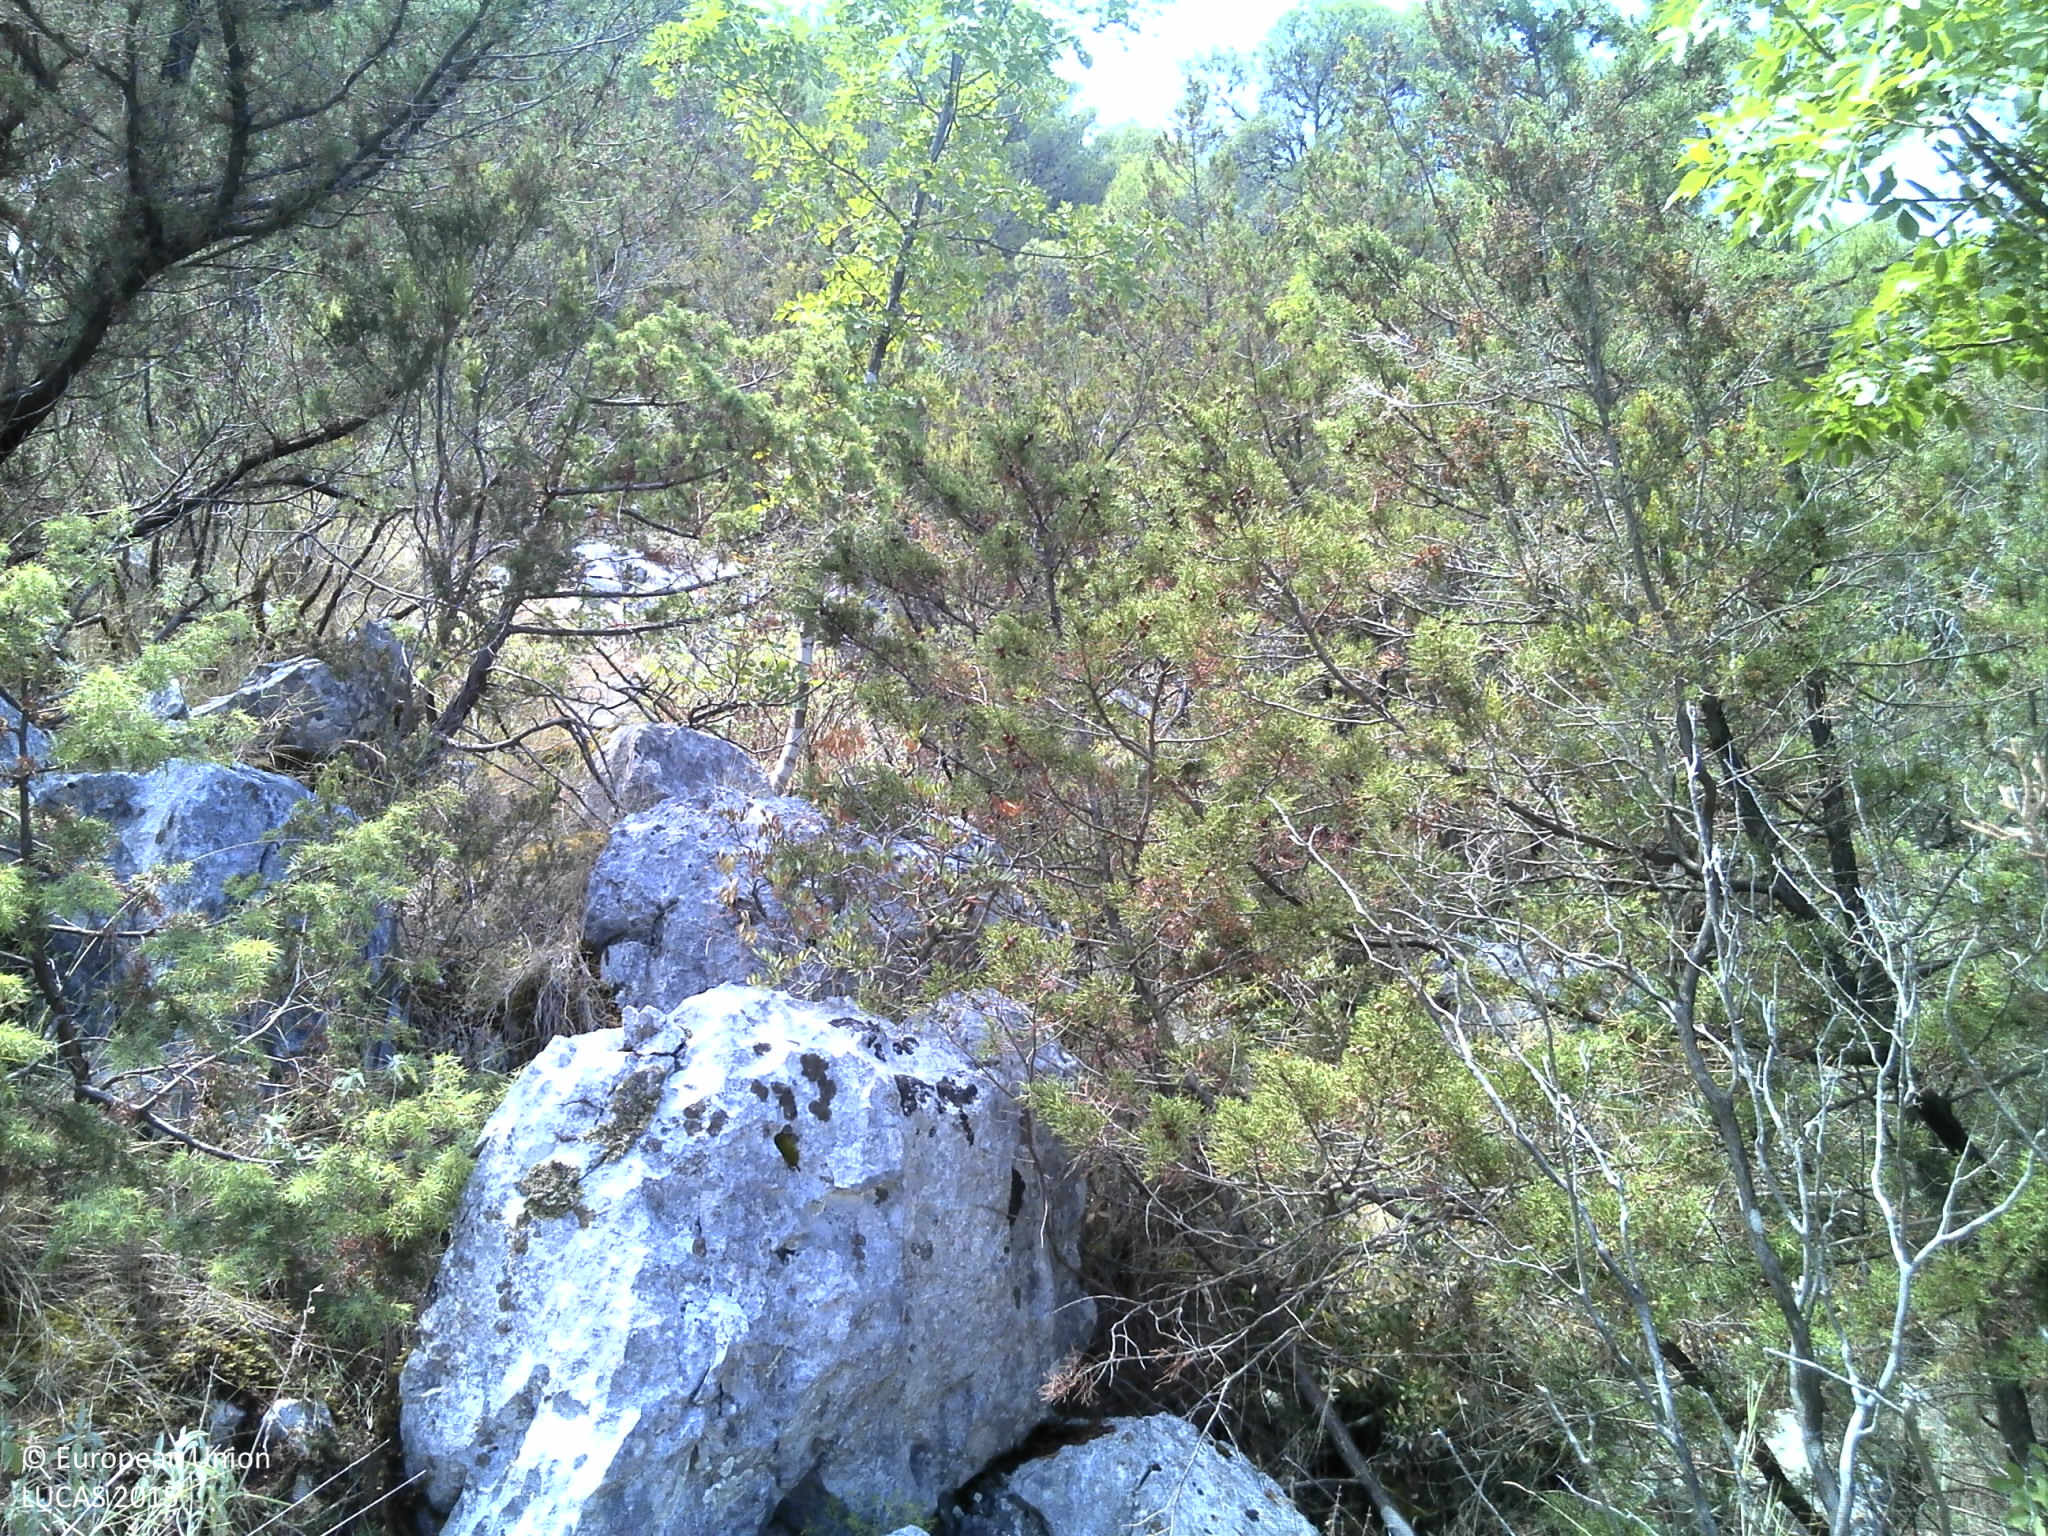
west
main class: Shrubland
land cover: Shrubland with sparse tree cover
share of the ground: > 75 %
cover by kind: shrubs 70 %, unconsolidated bare surface 10 %, broadleaved forest trees 5 %, herbaceous plants 5 %, lichens and mosses 5 %, consolidated bare surface 5 %
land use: Semi-natural and natural areas not in use
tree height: < 5 m
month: August
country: HR
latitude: 43.1357
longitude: 17.0098
